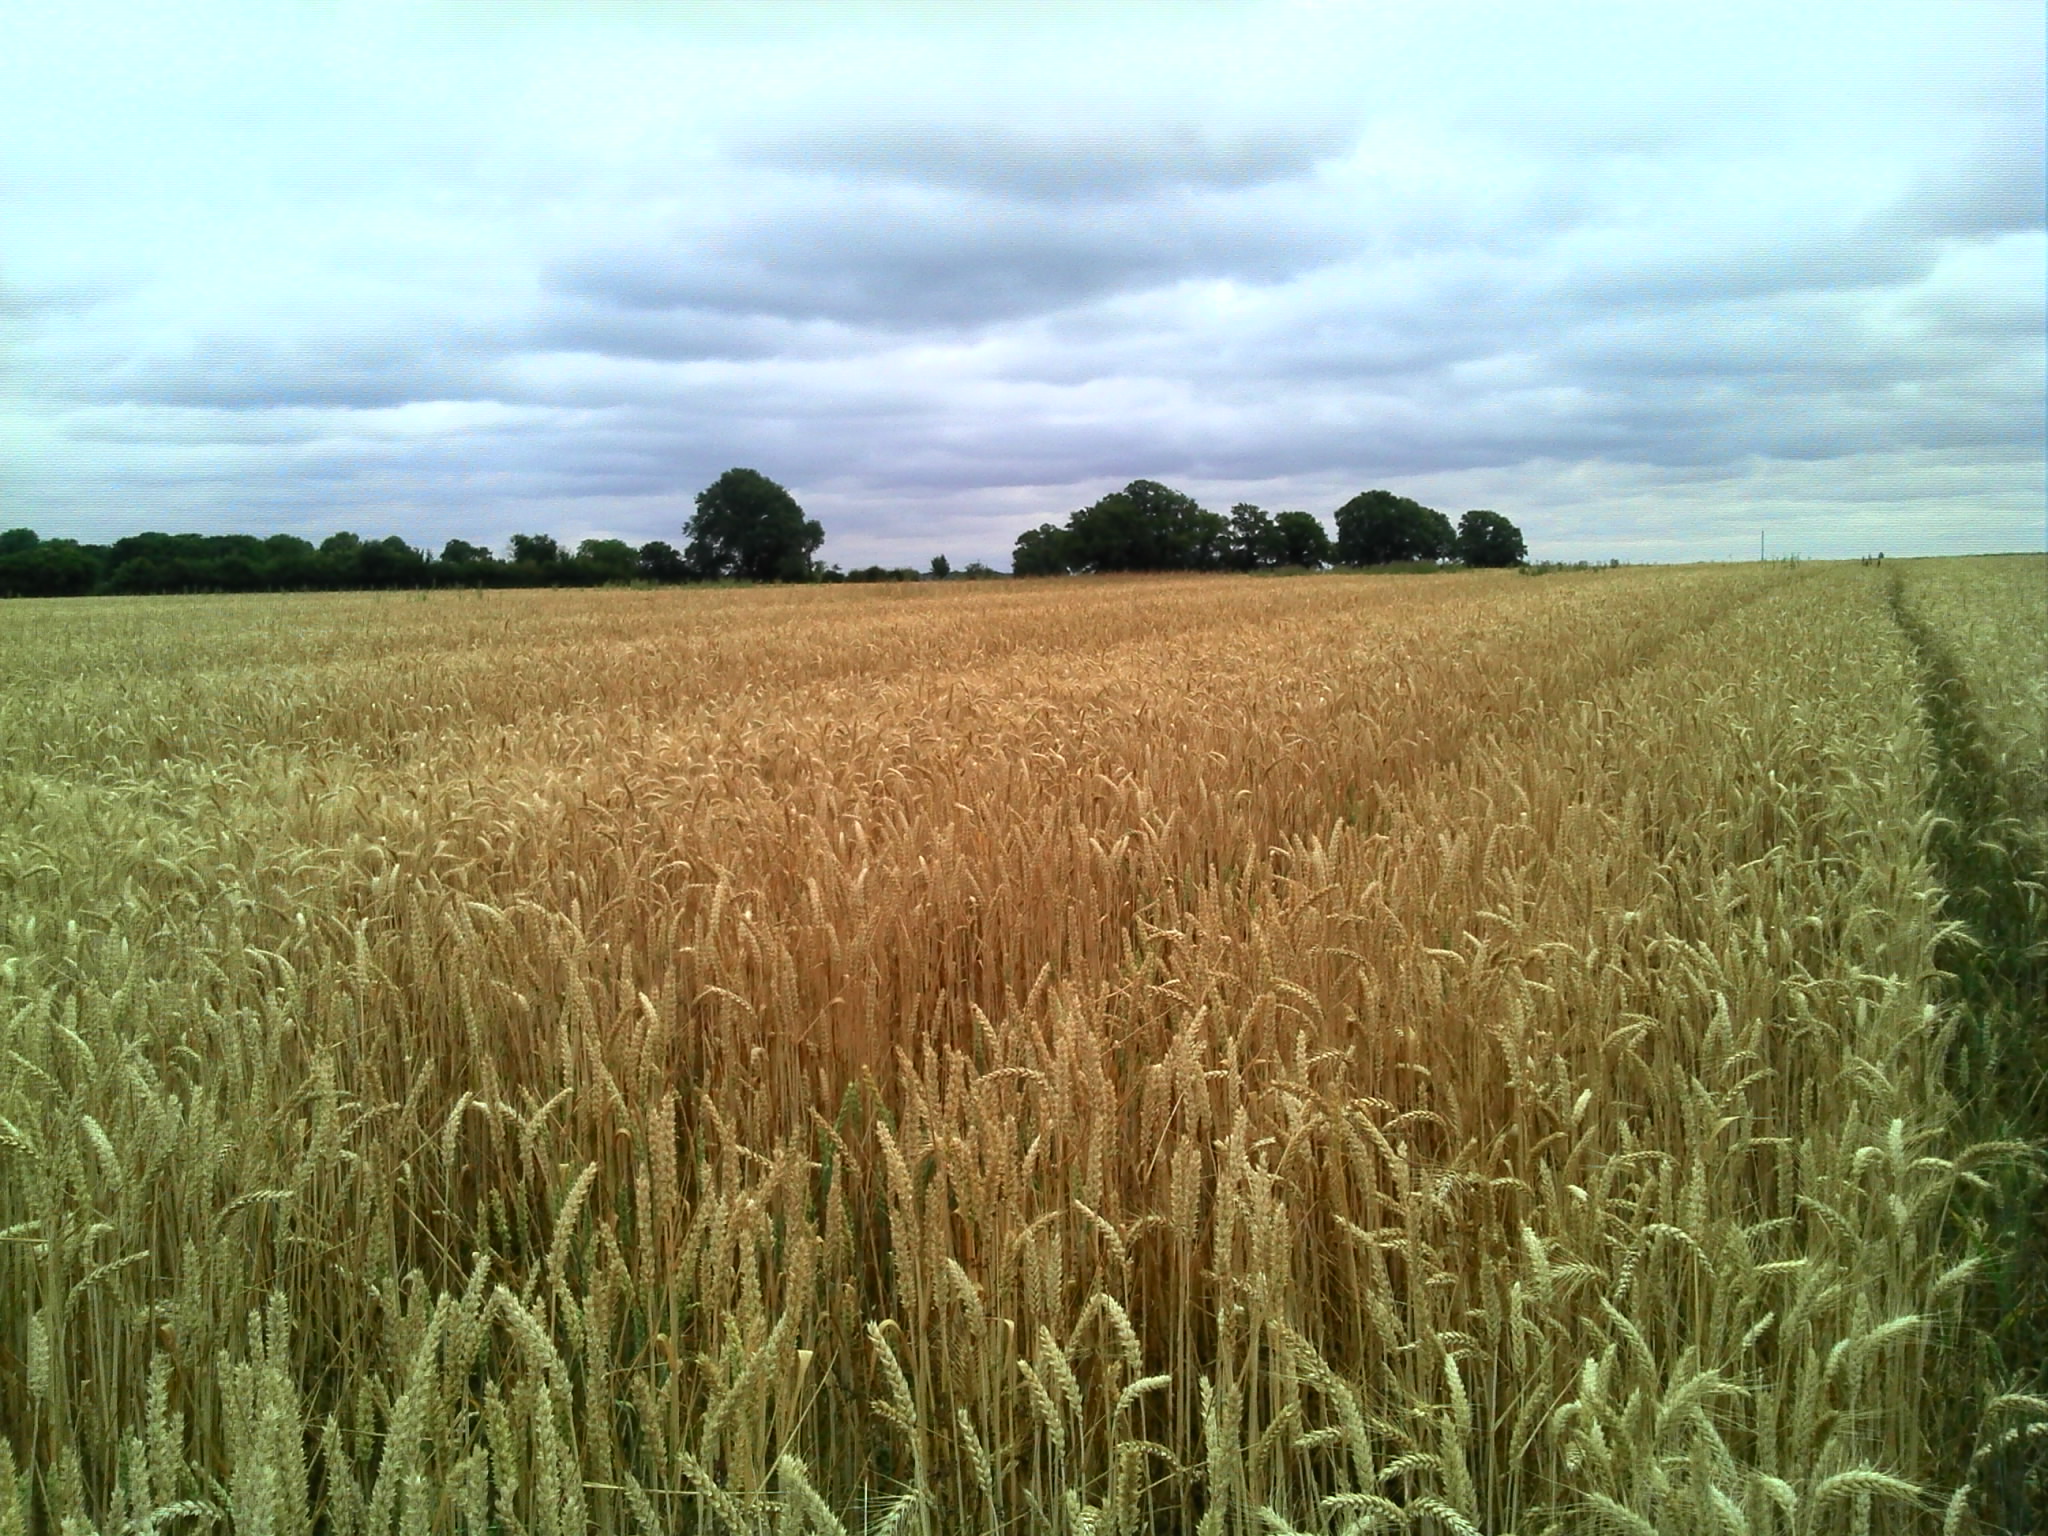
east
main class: Cropland
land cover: Common wheat
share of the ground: > 75 %
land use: Agriculture (excluding fallow land and kitchen gardens)
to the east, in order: Common wheat
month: July
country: FR
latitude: 48.8280
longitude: 0.7272
